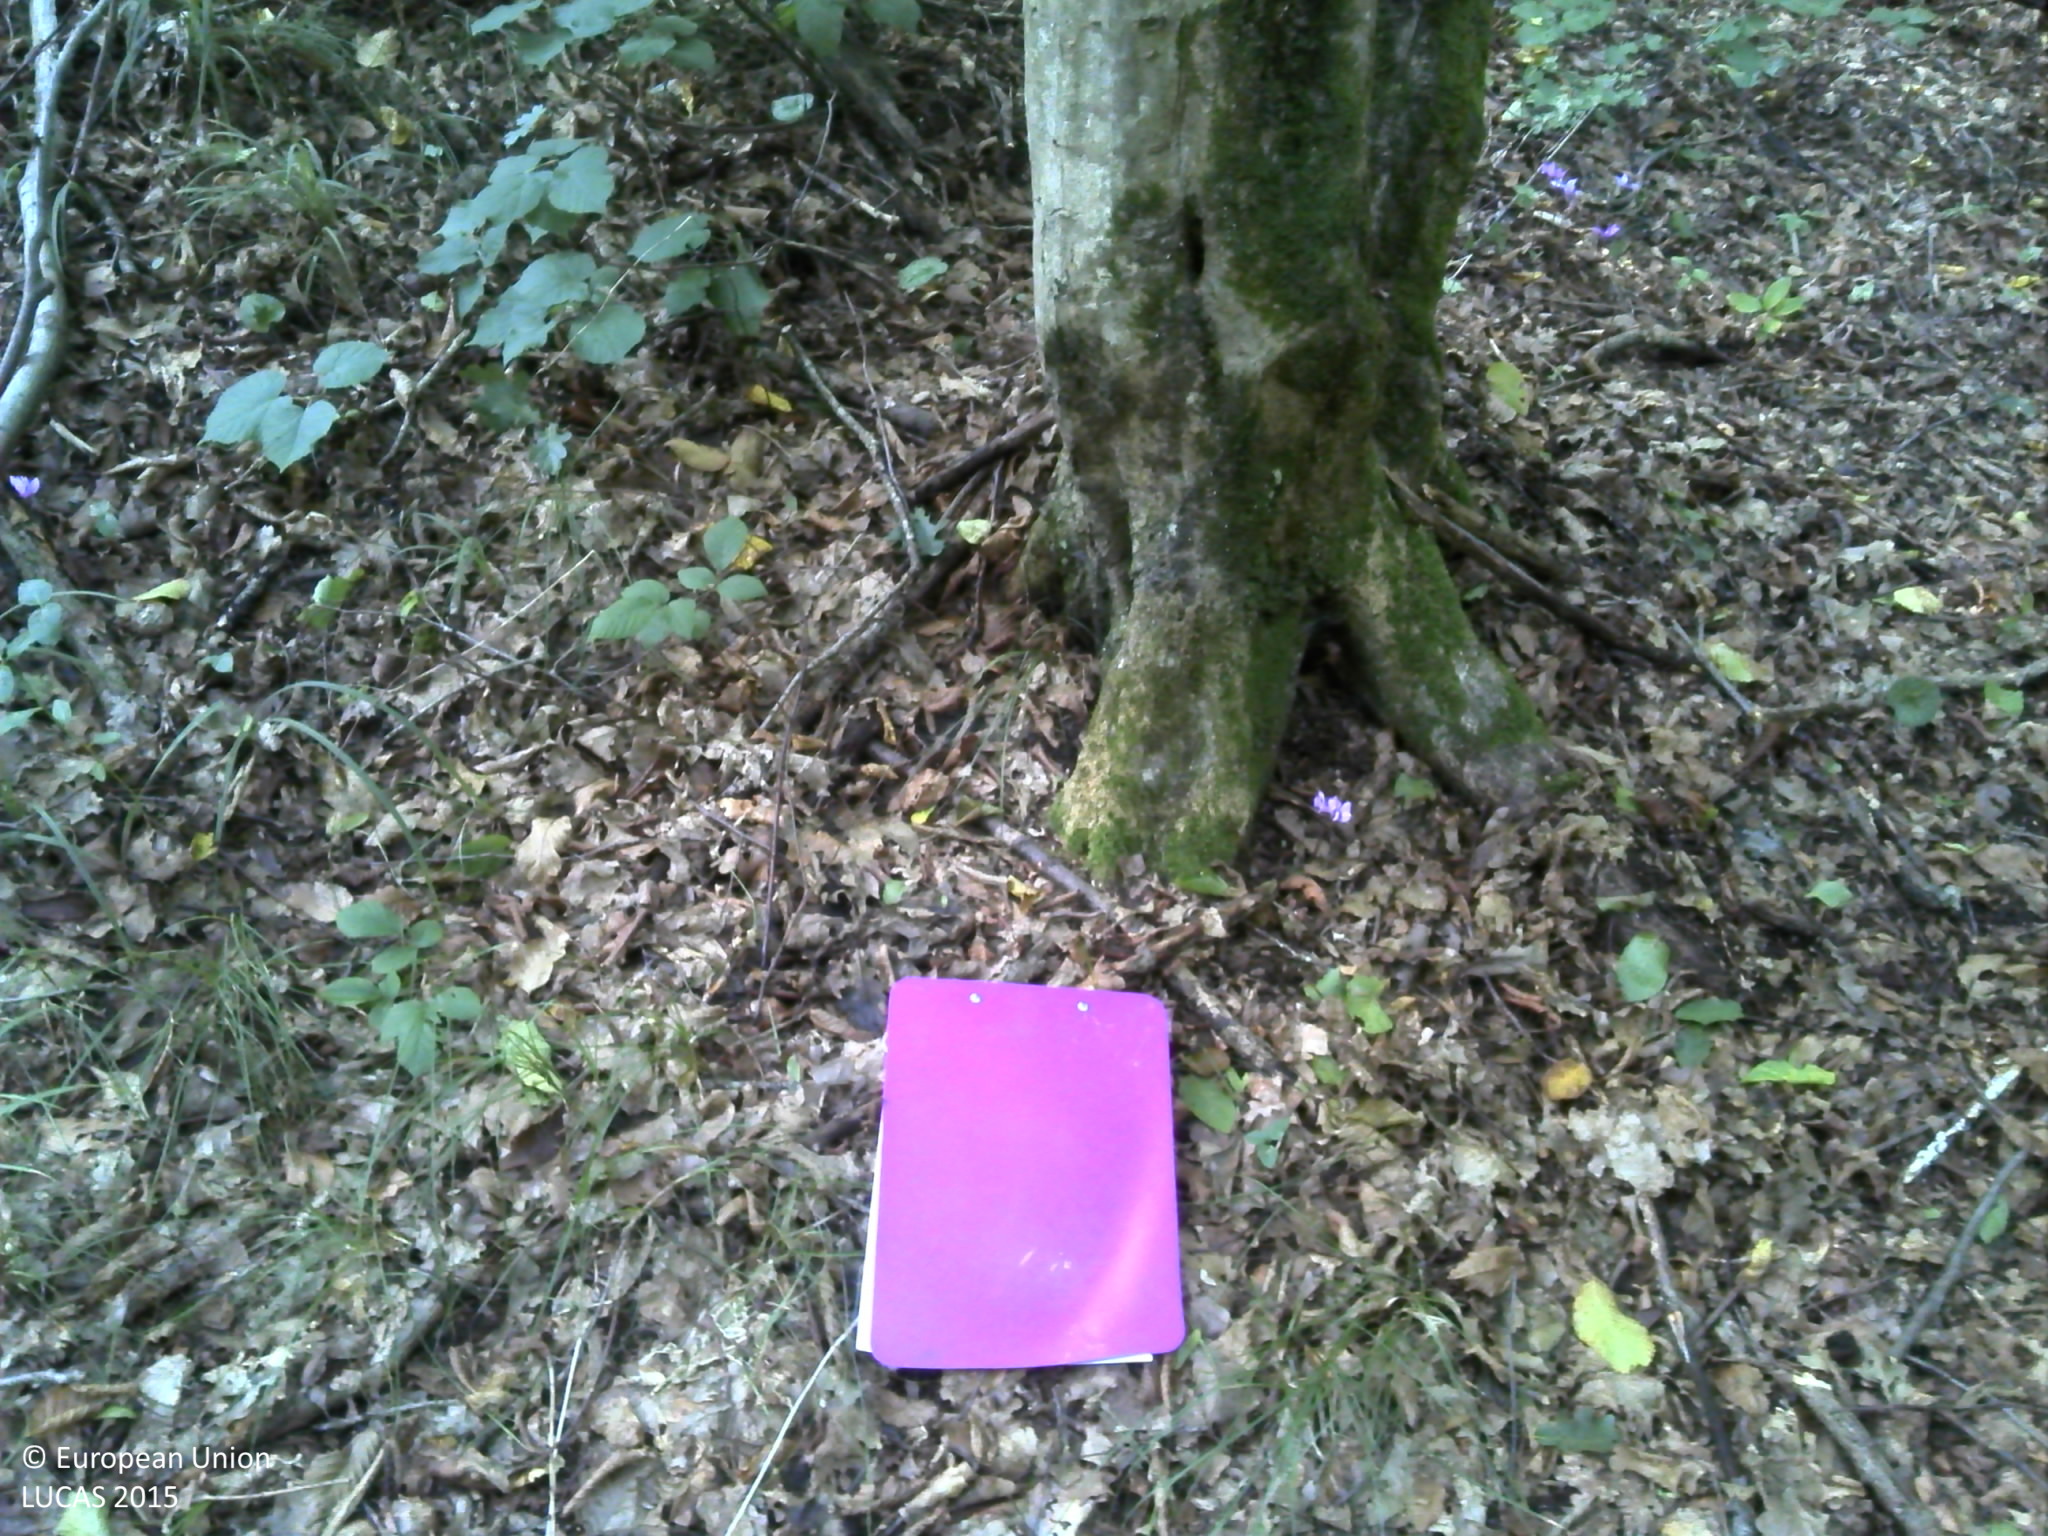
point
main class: Woodland
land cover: Broadleaved woodland
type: beech forest
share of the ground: > 75 %
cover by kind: broadleaved forest trees 100 %
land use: Forestry
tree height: > 5 m
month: August
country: HR
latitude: 45.2641
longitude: 16.5610
